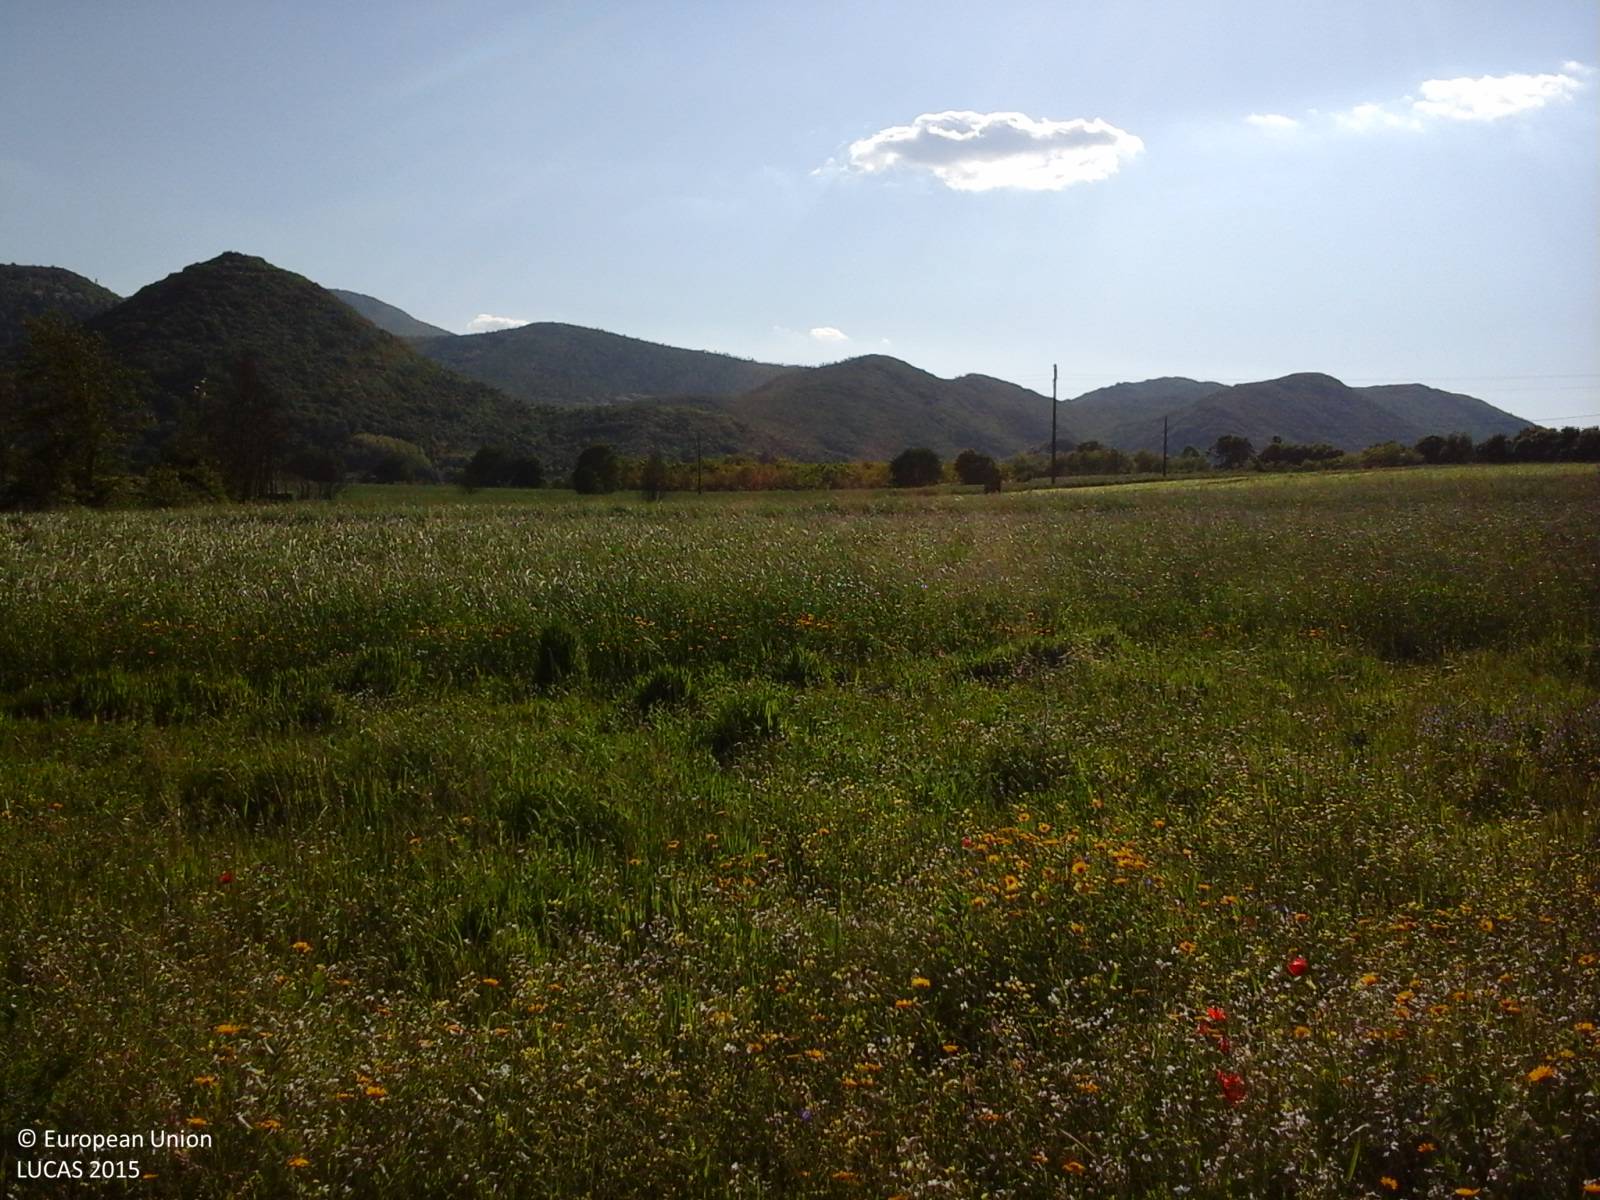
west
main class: Grassland
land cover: Spontaneously vegetated surfaces
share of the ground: > 75 %
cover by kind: herbaceous plants 100 %
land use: Agriculture (excluding fallow land and kitchen gardens)
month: May
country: IT
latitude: 41.2773
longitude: 14.3173
